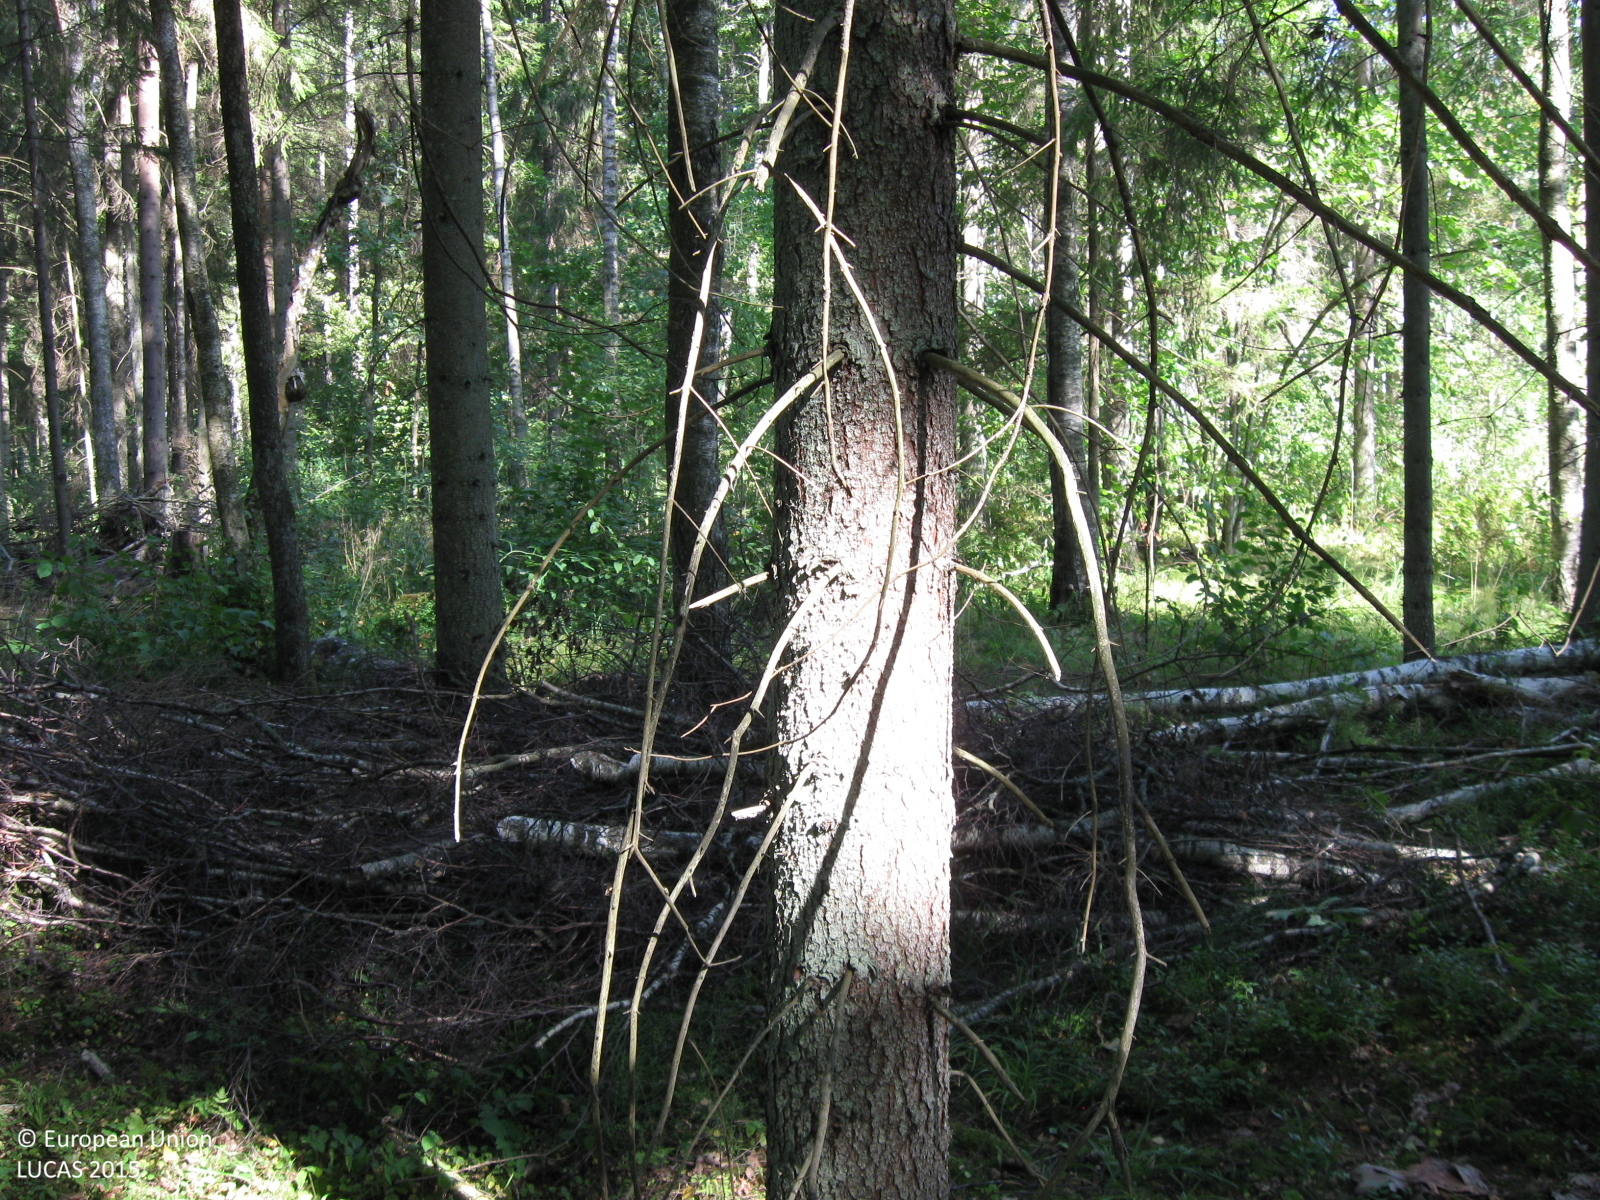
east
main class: Woodland
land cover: Spruce dominated mixed woodland
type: hemiboreal forest and nemoral coniferous forest and mixed broadleaved-coniferous forest
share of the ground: > 75 %
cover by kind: broadleaved forest trees 45 %, coniferous forest trees 40 %, herbaceous plants 10 %, lichens and mosses 5 %
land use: Forestry
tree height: > 5 m
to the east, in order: Spruce dominated mixed woodland; Other mixed woodland
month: August
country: LT
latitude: 55.3096
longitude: 22.5881
